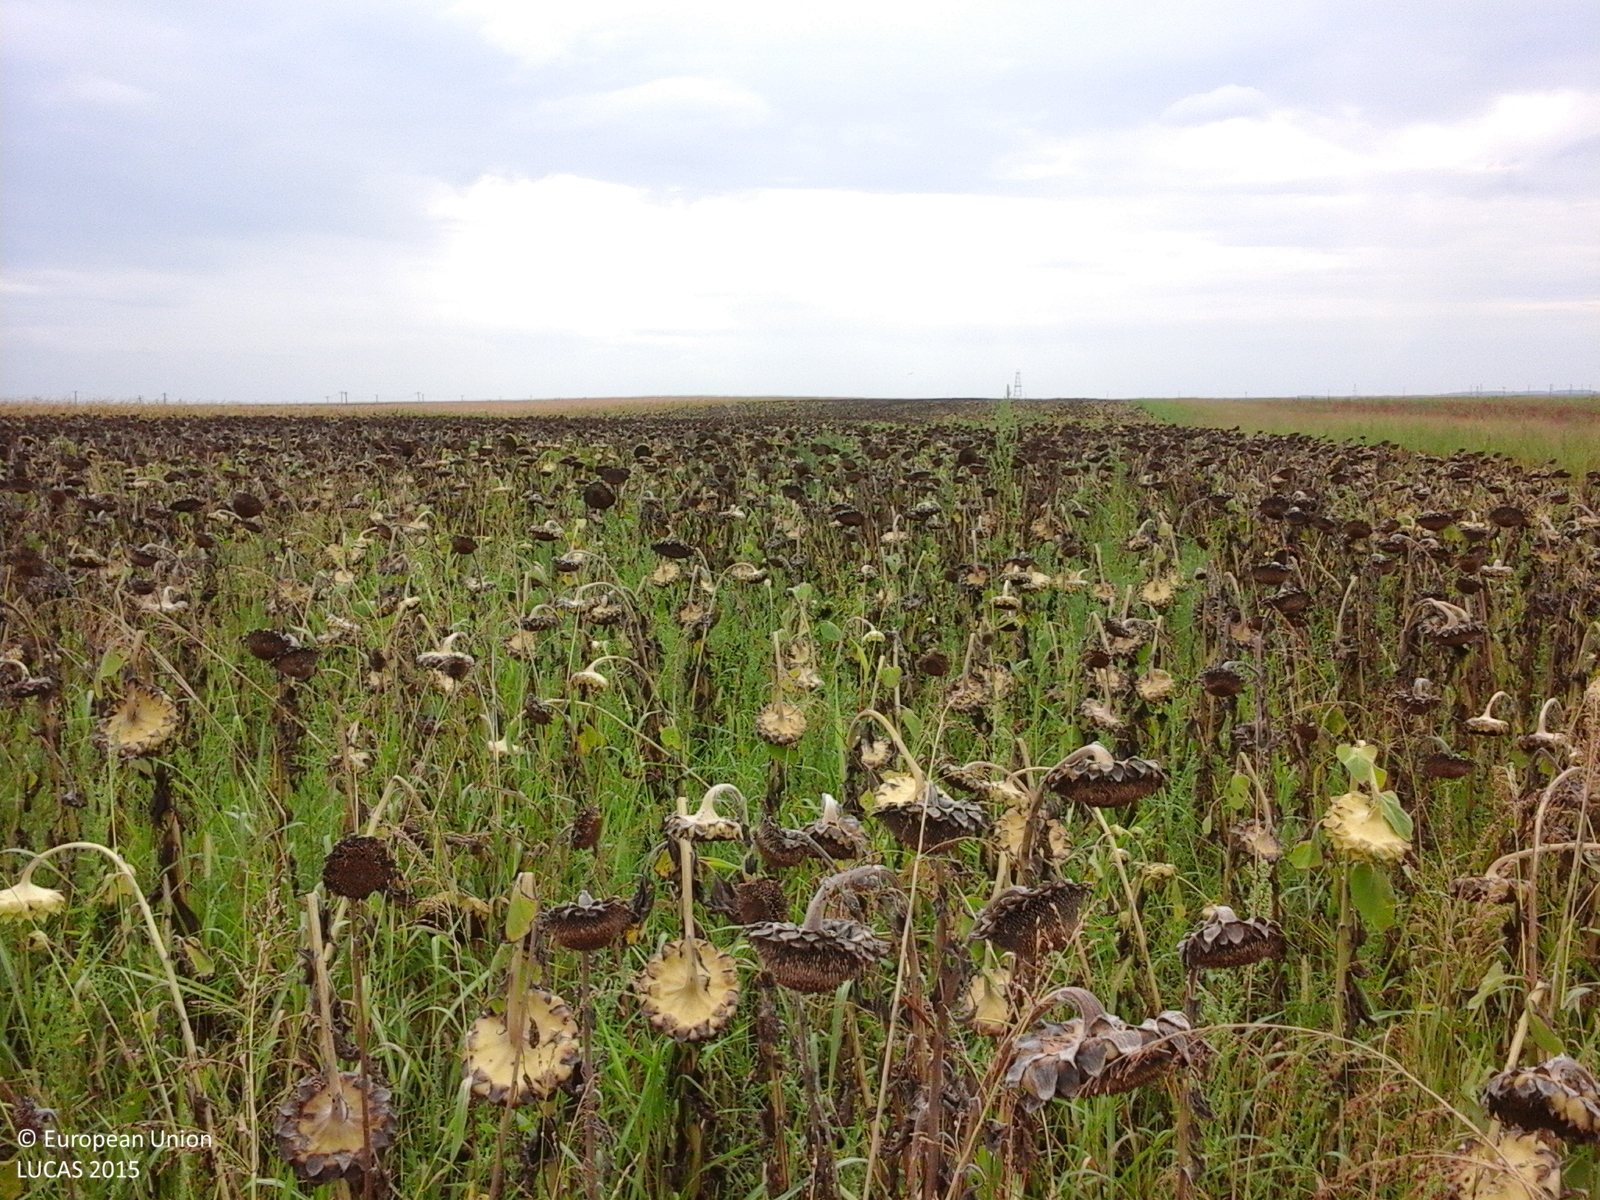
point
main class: Cropland
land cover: Sunflower
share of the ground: > 75 %
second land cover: Spontaneously vegetated surfaces
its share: 50 - 75 %
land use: Agriculture (excluding fallow land and kitchen gardens)
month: August
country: RO
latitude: 45.9654
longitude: 20.9848
